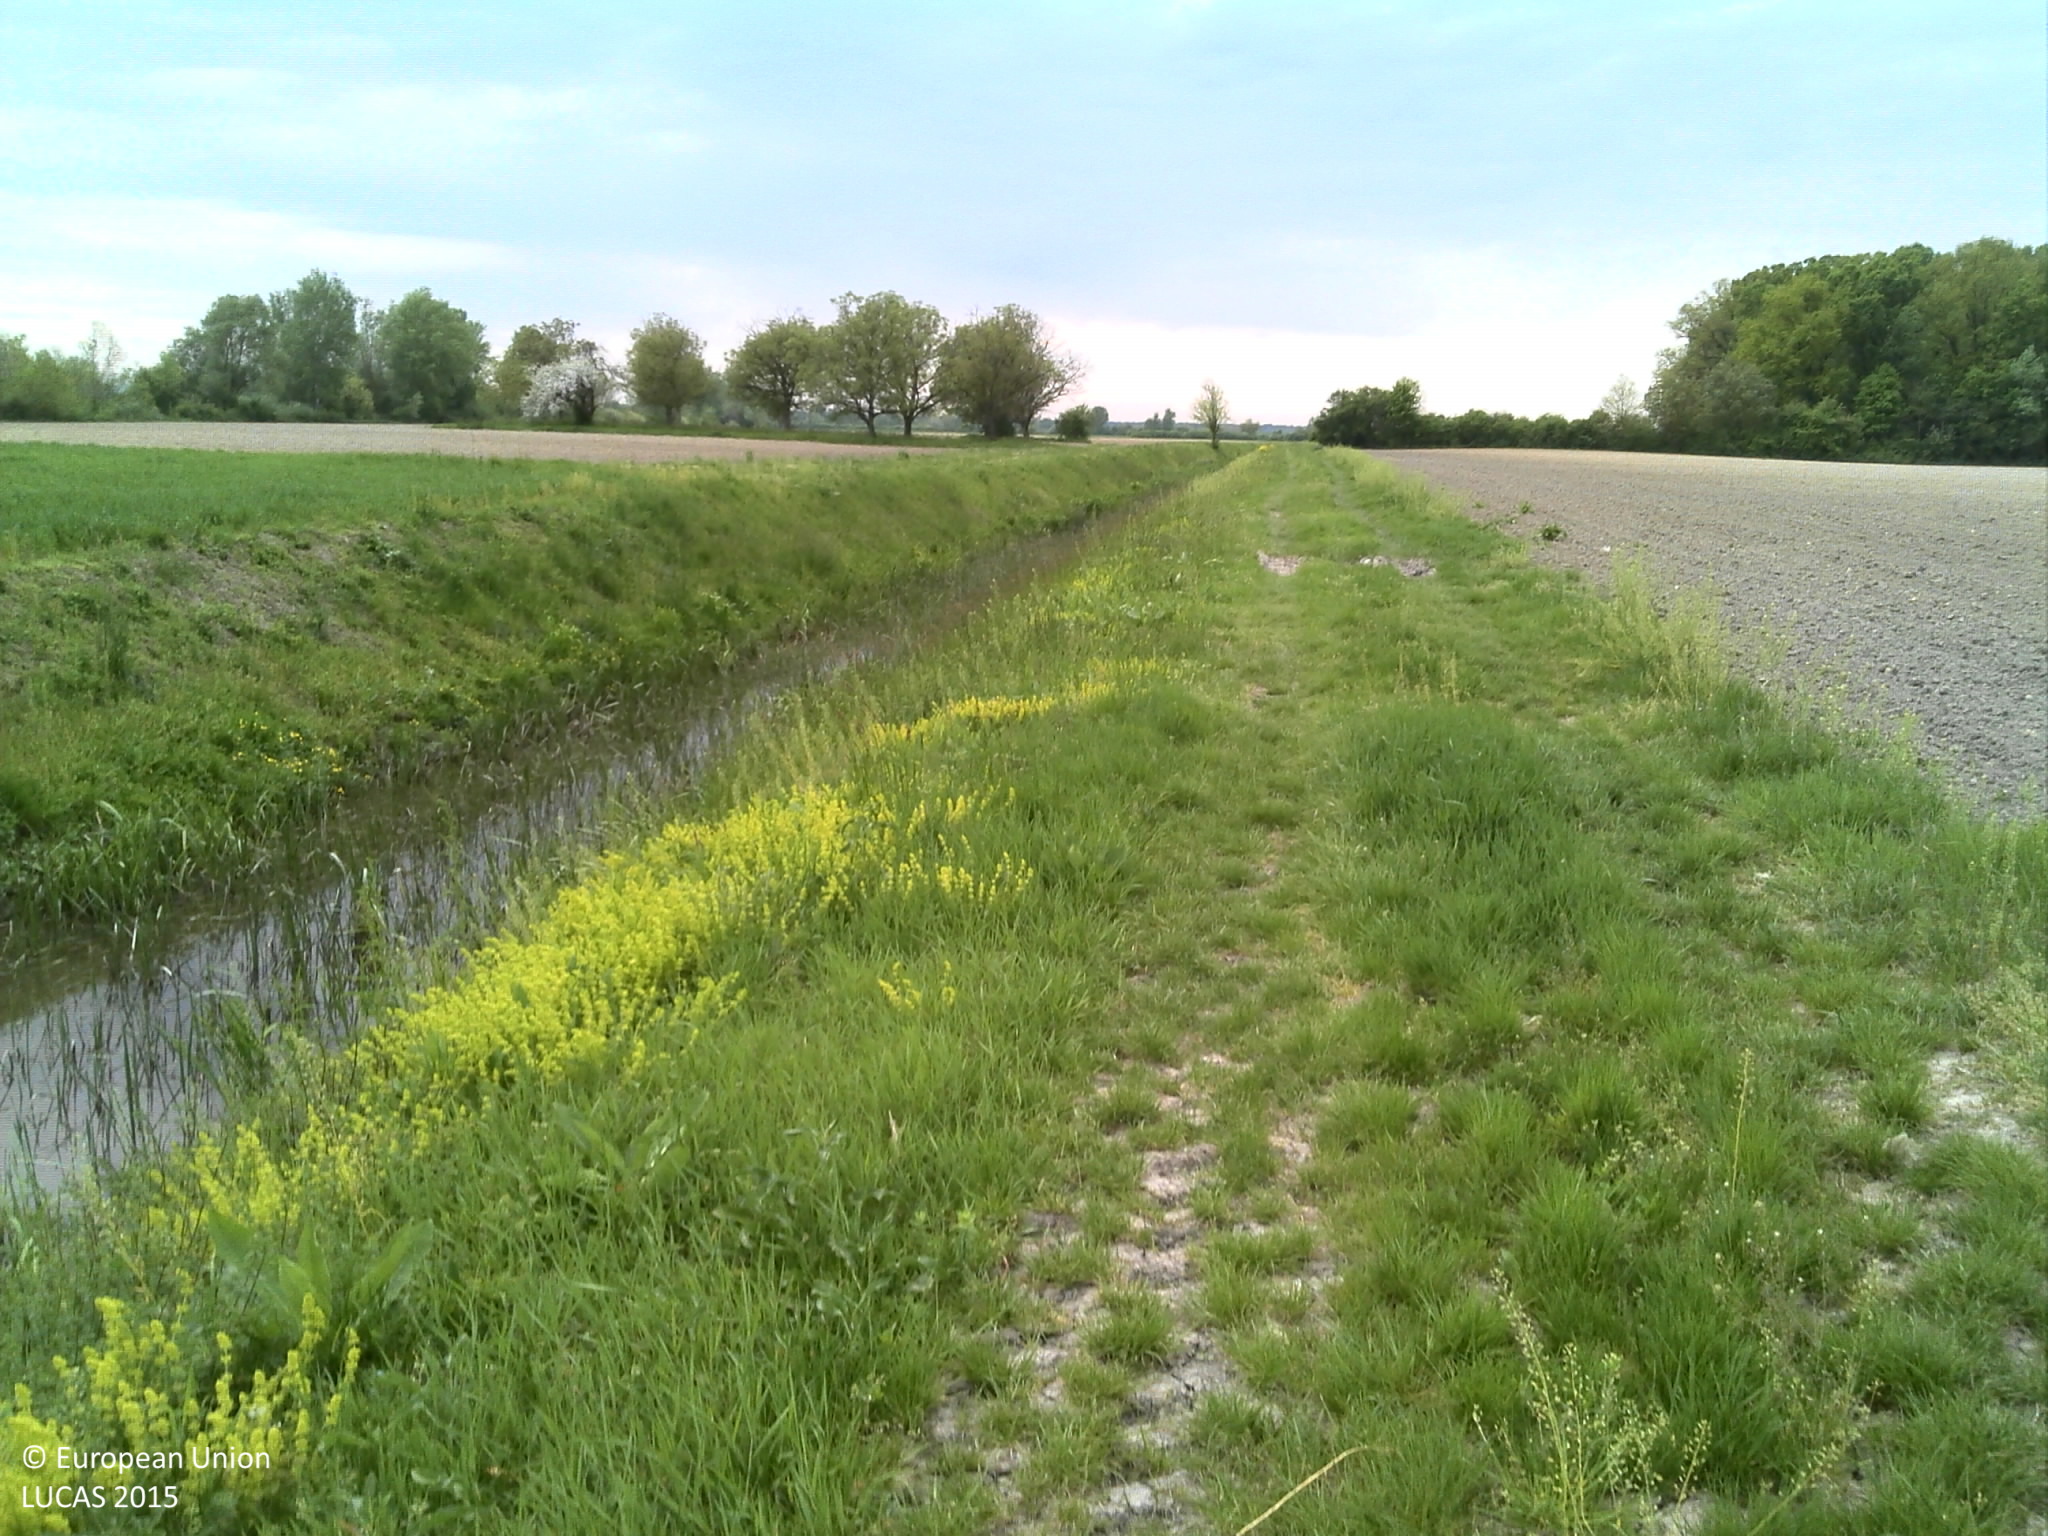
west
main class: Cropland
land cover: Soya
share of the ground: < 10 %
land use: Agriculture (excluding fallow land and kitchen gardens)
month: April
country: HR
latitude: 44.9610
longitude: 18.9440
